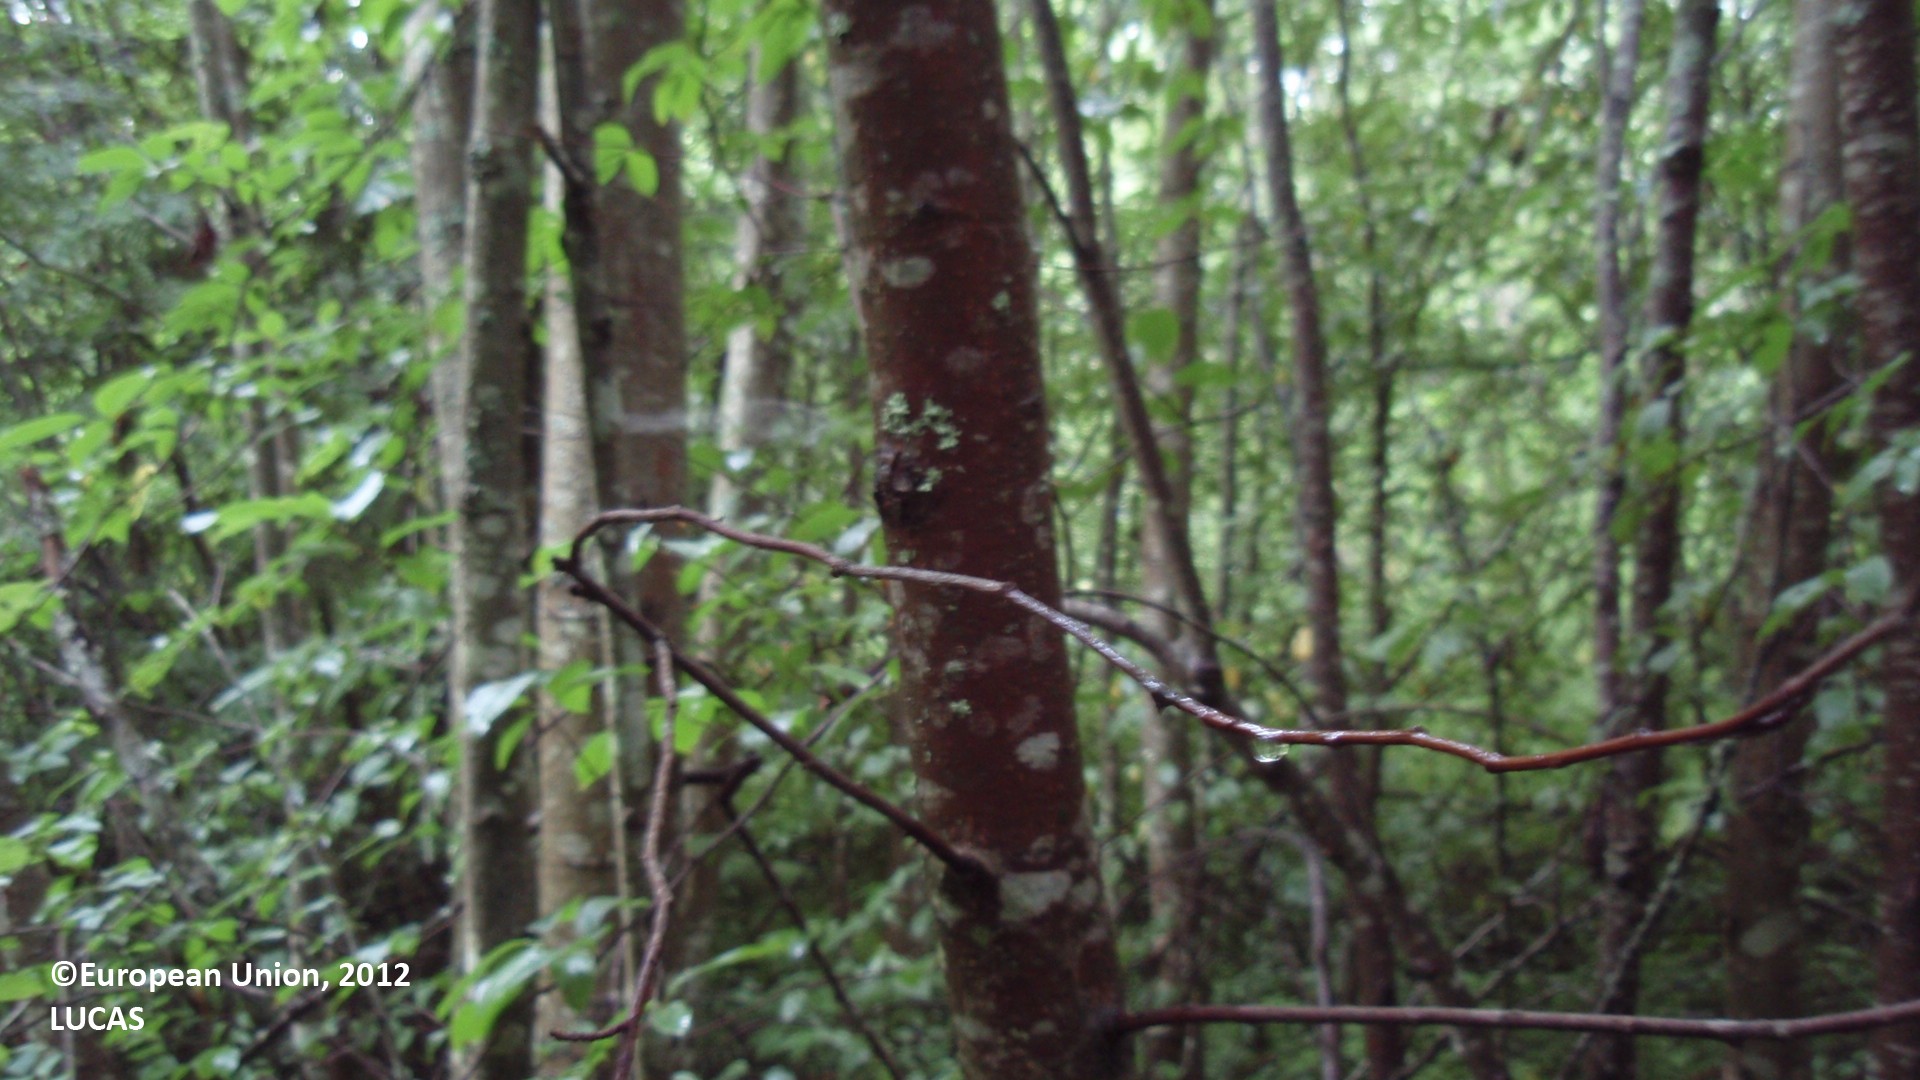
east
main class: Woodland
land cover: Broadleaved woodland
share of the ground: > 75 %
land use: Forestry
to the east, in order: Broadleaved woodland; Ditches and canals; Tracks; Shrubland with sparse tree cover; Broadleaved woodland; Spruce dominated mixed woodland; Grass margins; Ditches and canals; Paved roads, cycling and walking lanes; Ditches and canals; Grass margins; Other mixed woodland; Shrubland with sparse tree cover; Broadleaved woodland
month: July
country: FI
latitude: 61.5460
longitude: 27.2723
